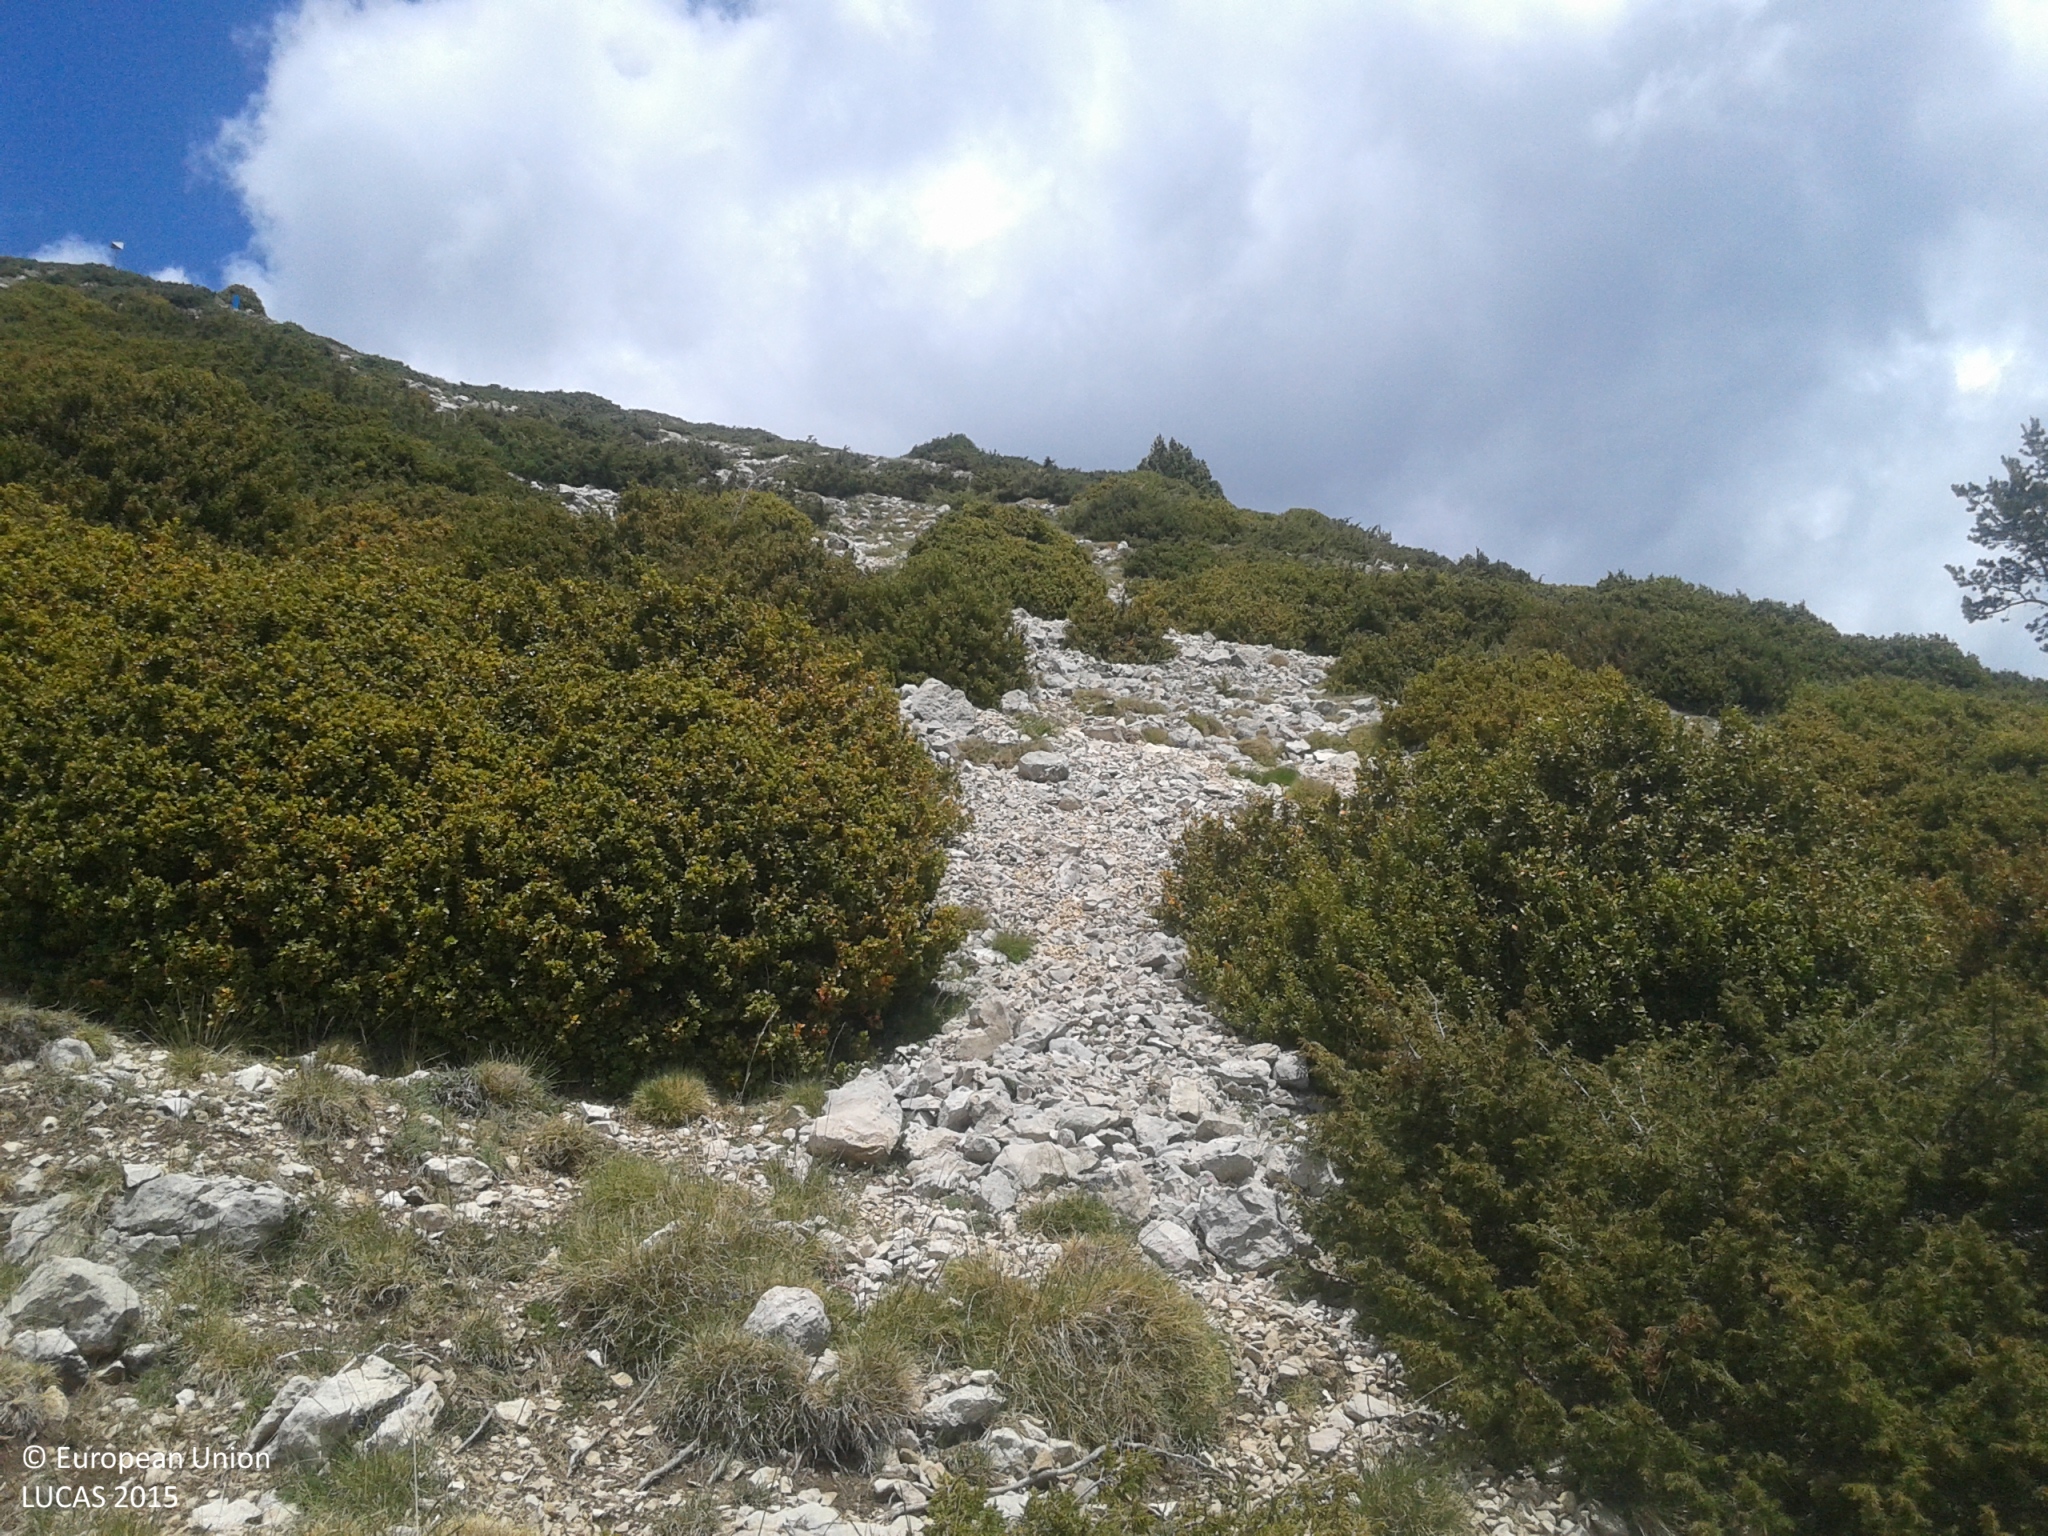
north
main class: Woodland
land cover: Pine dominated coniferous woodland
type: alpine coniferous forest
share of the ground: 10 - 25 %
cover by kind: unconsolidated bare surface 80 %, coniferous forest trees 15 %, shrubs 5 %
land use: Semi-natural and natural areas not in use
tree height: > 5 m
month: May
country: ES
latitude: 42.1554
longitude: 1.5521
